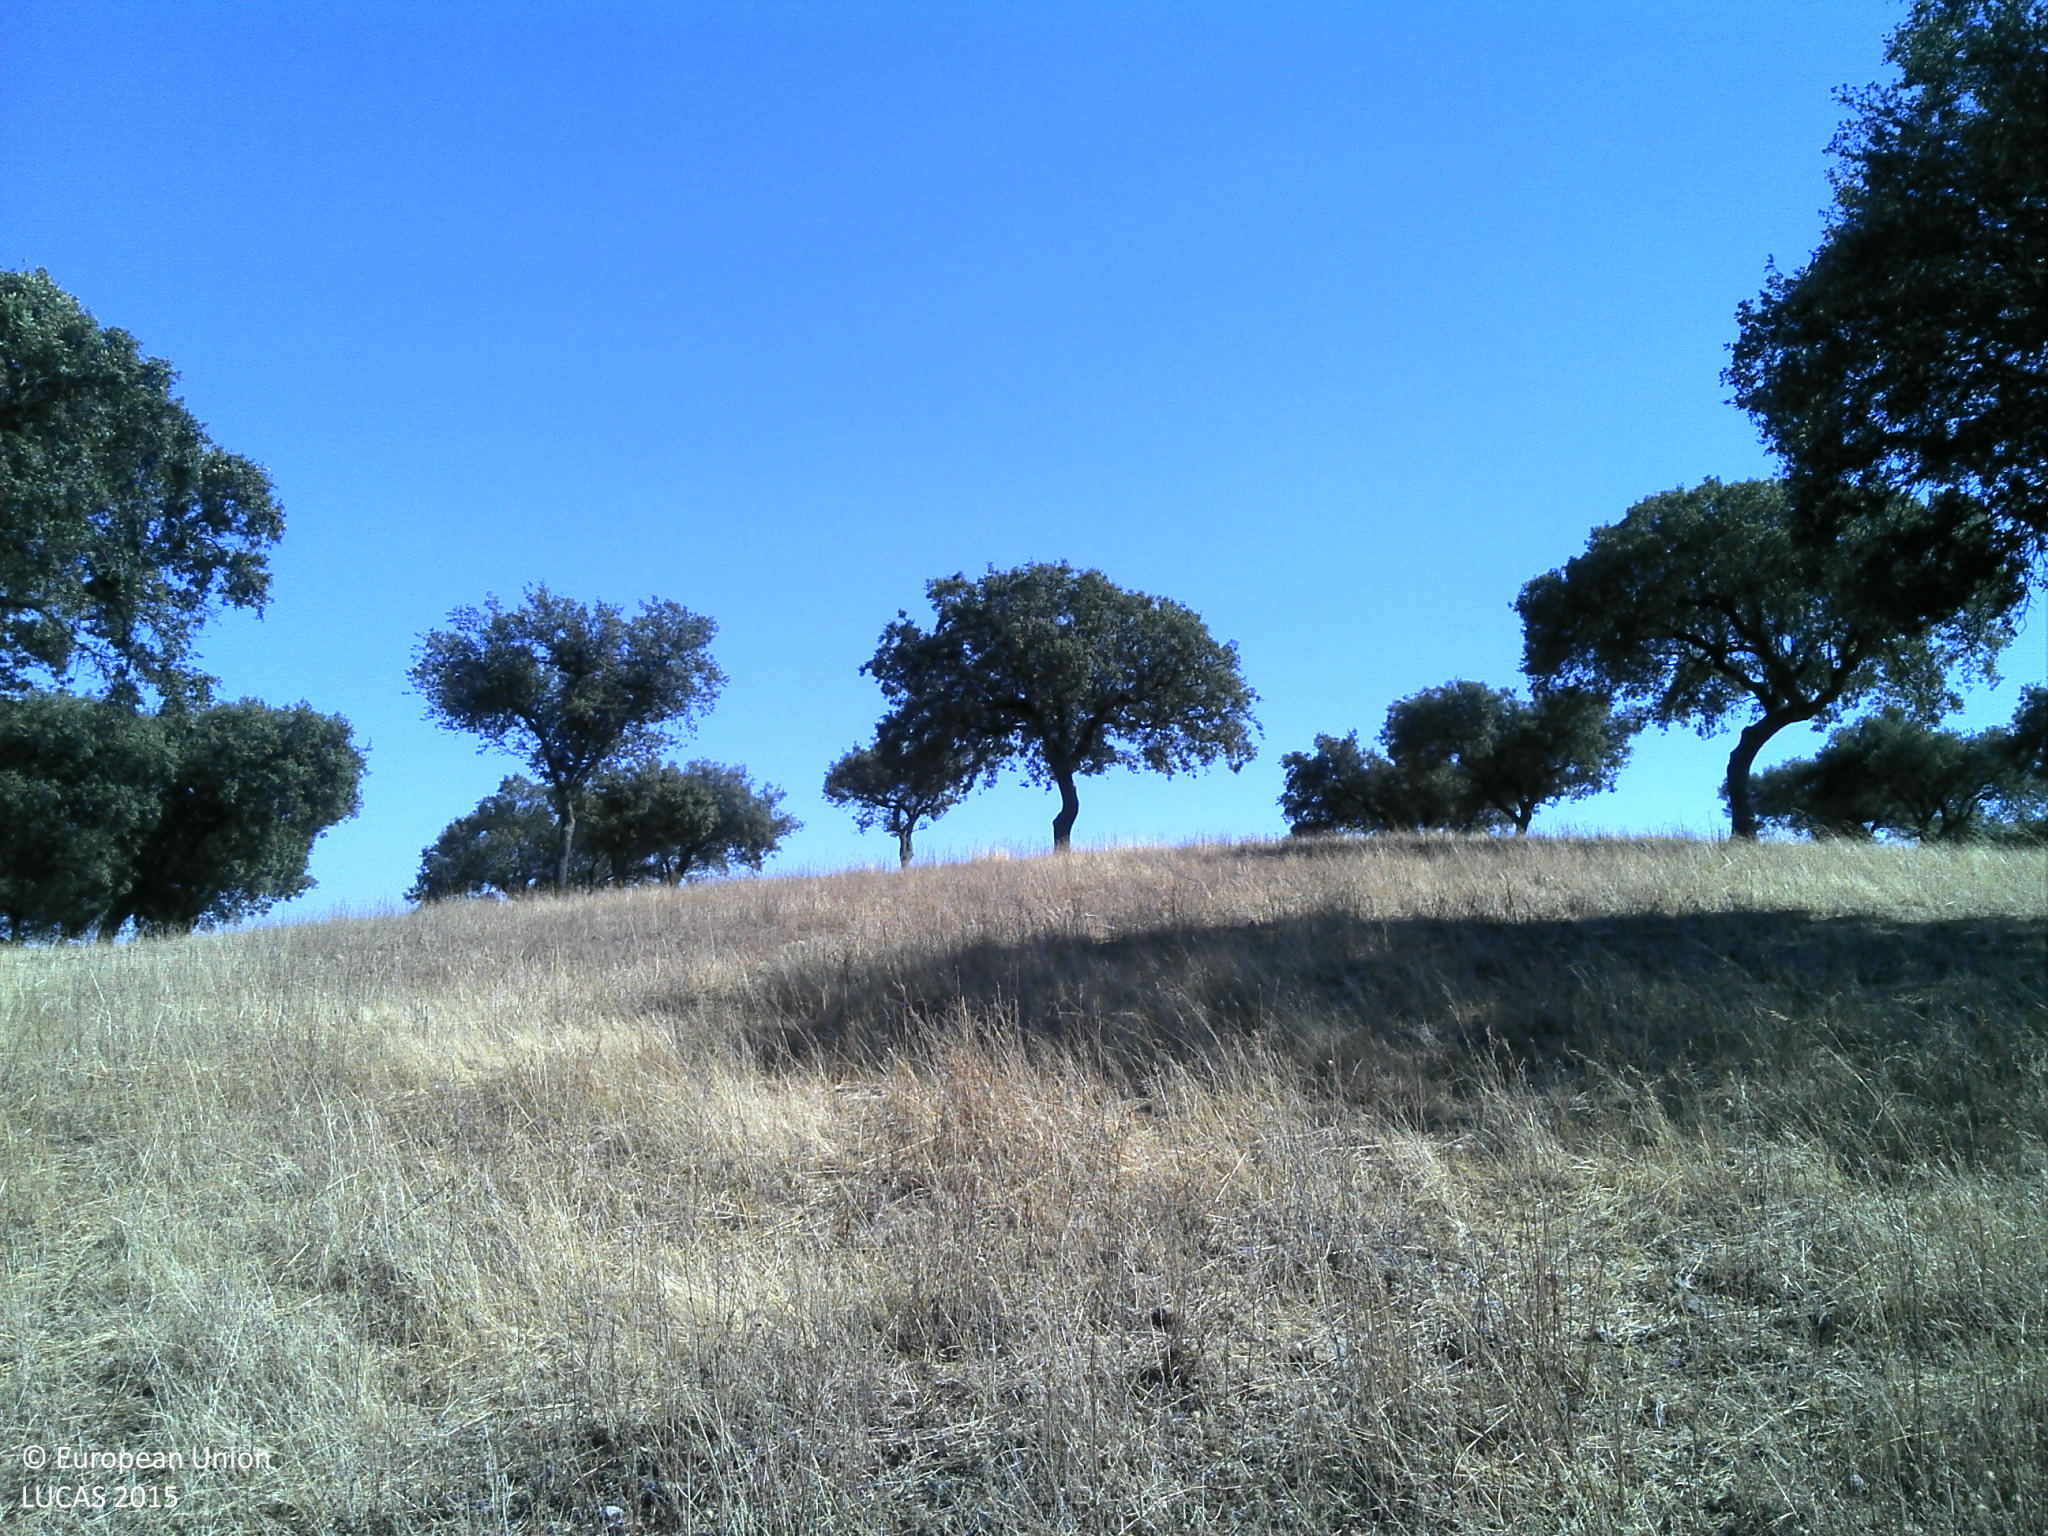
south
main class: Woodland
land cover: Broadleaved woodland
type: broadleaved evergreen forest
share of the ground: 10 - 25 %
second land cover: Grassland without tree/shrub cover
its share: 25 - 50 %
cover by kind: unconsolidated bare surface 50 %, herbaceous plants 30 %, broadleaved forest trees 20 %
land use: Forestry
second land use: Agriculture (excluding fallow land and kitchen gardens)
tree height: > 5 m
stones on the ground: < 10 %
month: July
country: PT
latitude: 38.5410
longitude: -7.4556
